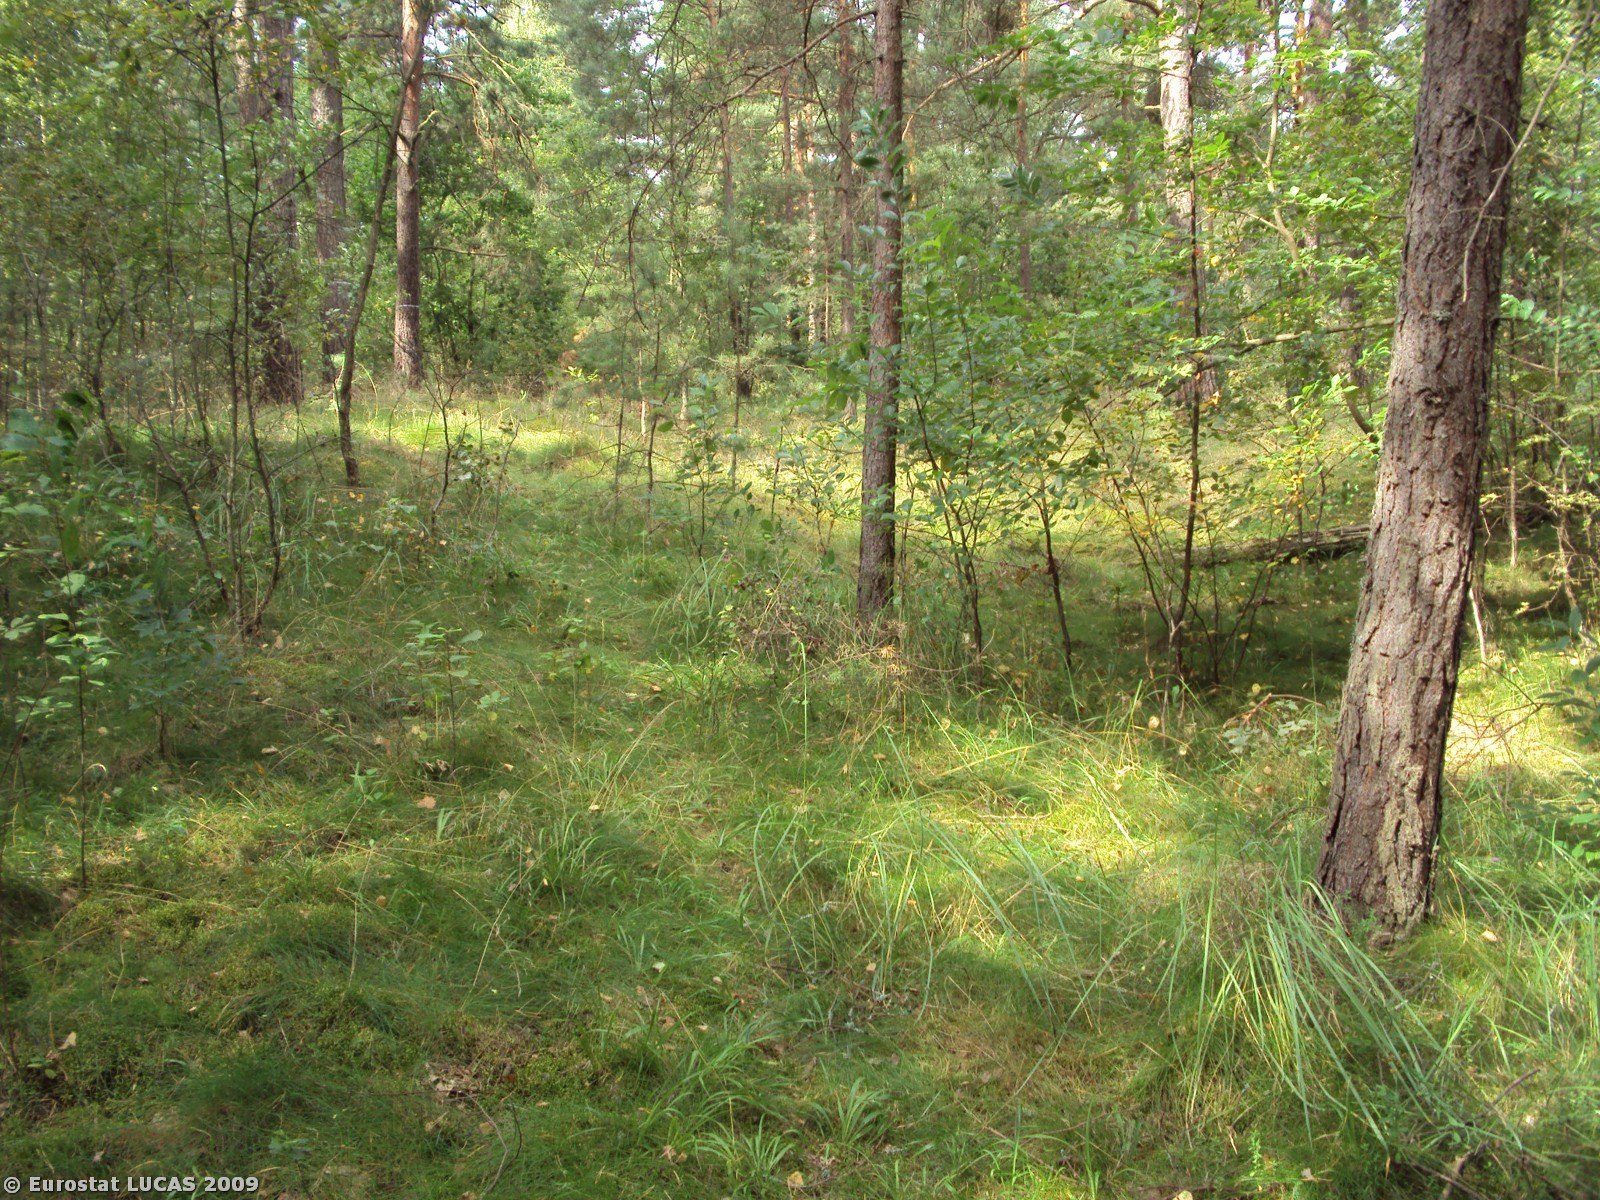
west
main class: Woodland
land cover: Mixed woodland
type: hemiboreal forest and nemoral coniferous forest and mixed broadleaved-coniferous forest
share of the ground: > 75 %
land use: Forestry
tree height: > 5 m
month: August
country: PL
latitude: 53.5871
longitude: 16.5177
